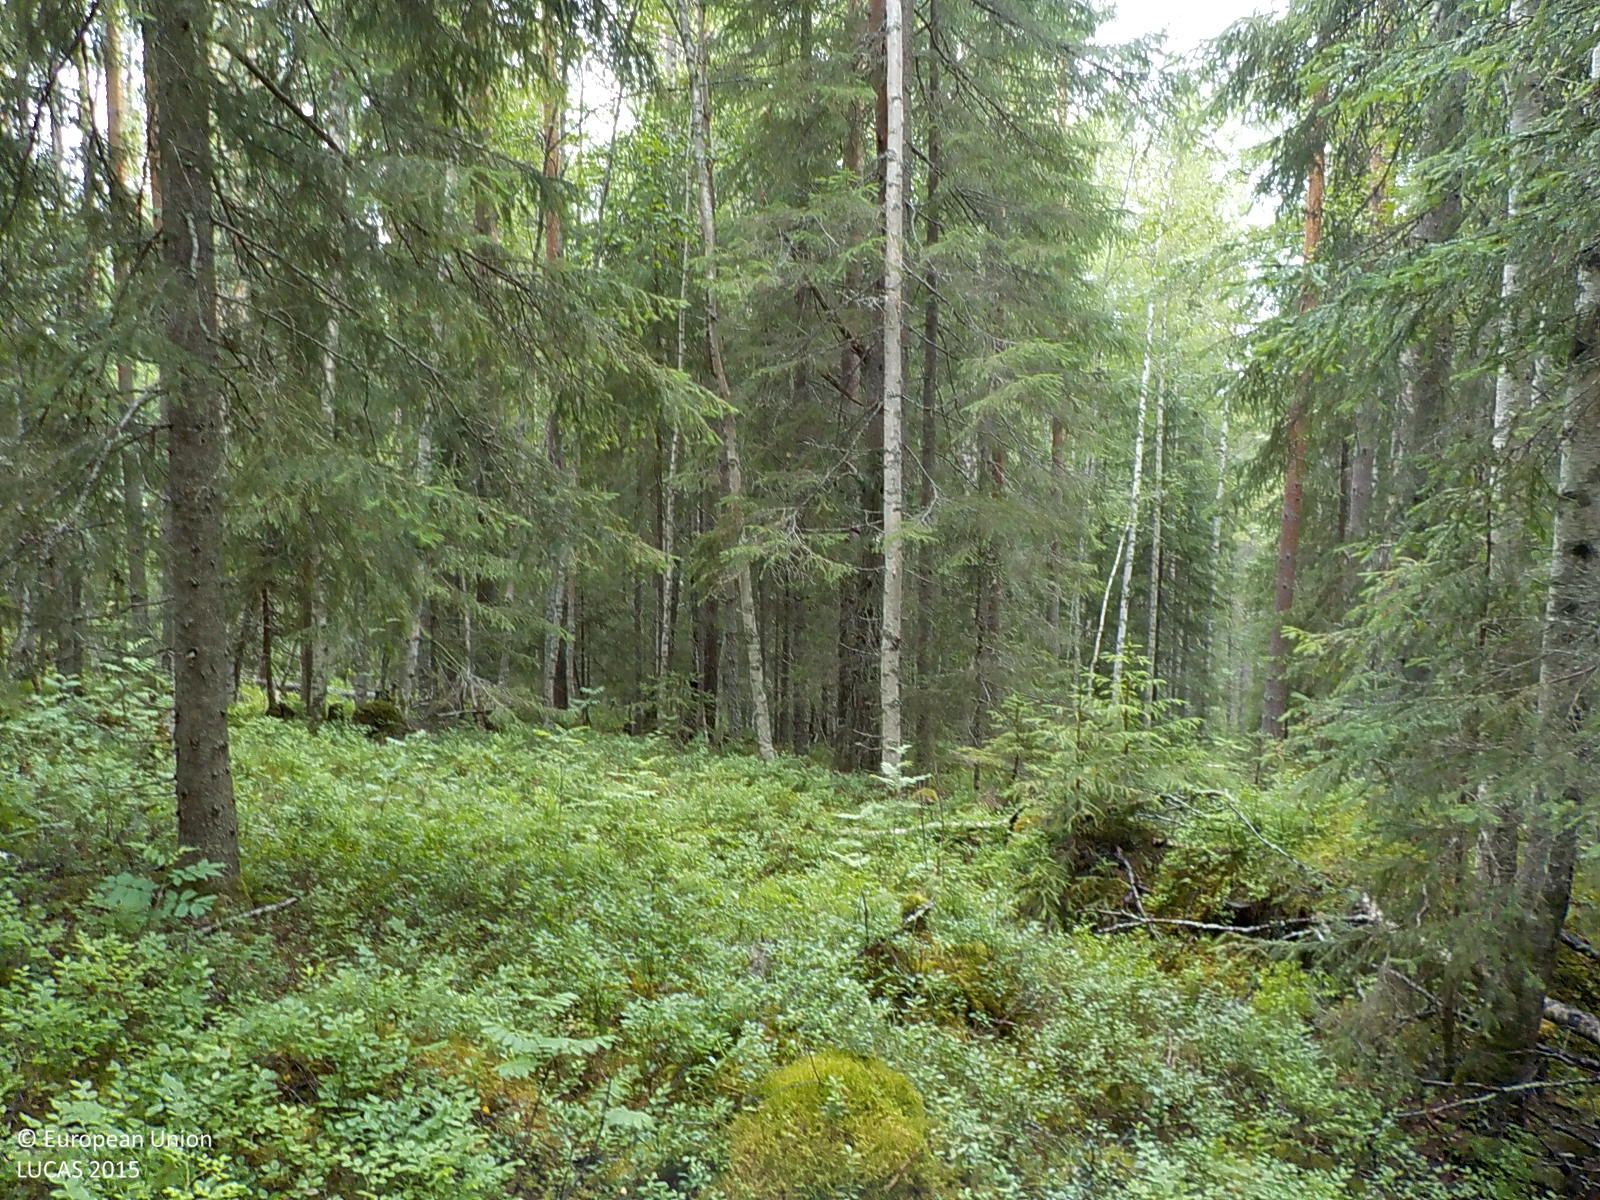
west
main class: Woodland
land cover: Spruce dominated coniferous woodland
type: boreal forest
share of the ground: 50 - 75 %
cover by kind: coniferous forest trees 60 %, shrubs 25 %, lichens and mosses 15 %
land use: Forestry
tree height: > 5 m
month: July
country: SE
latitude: 63.3090
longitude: 17.2185
